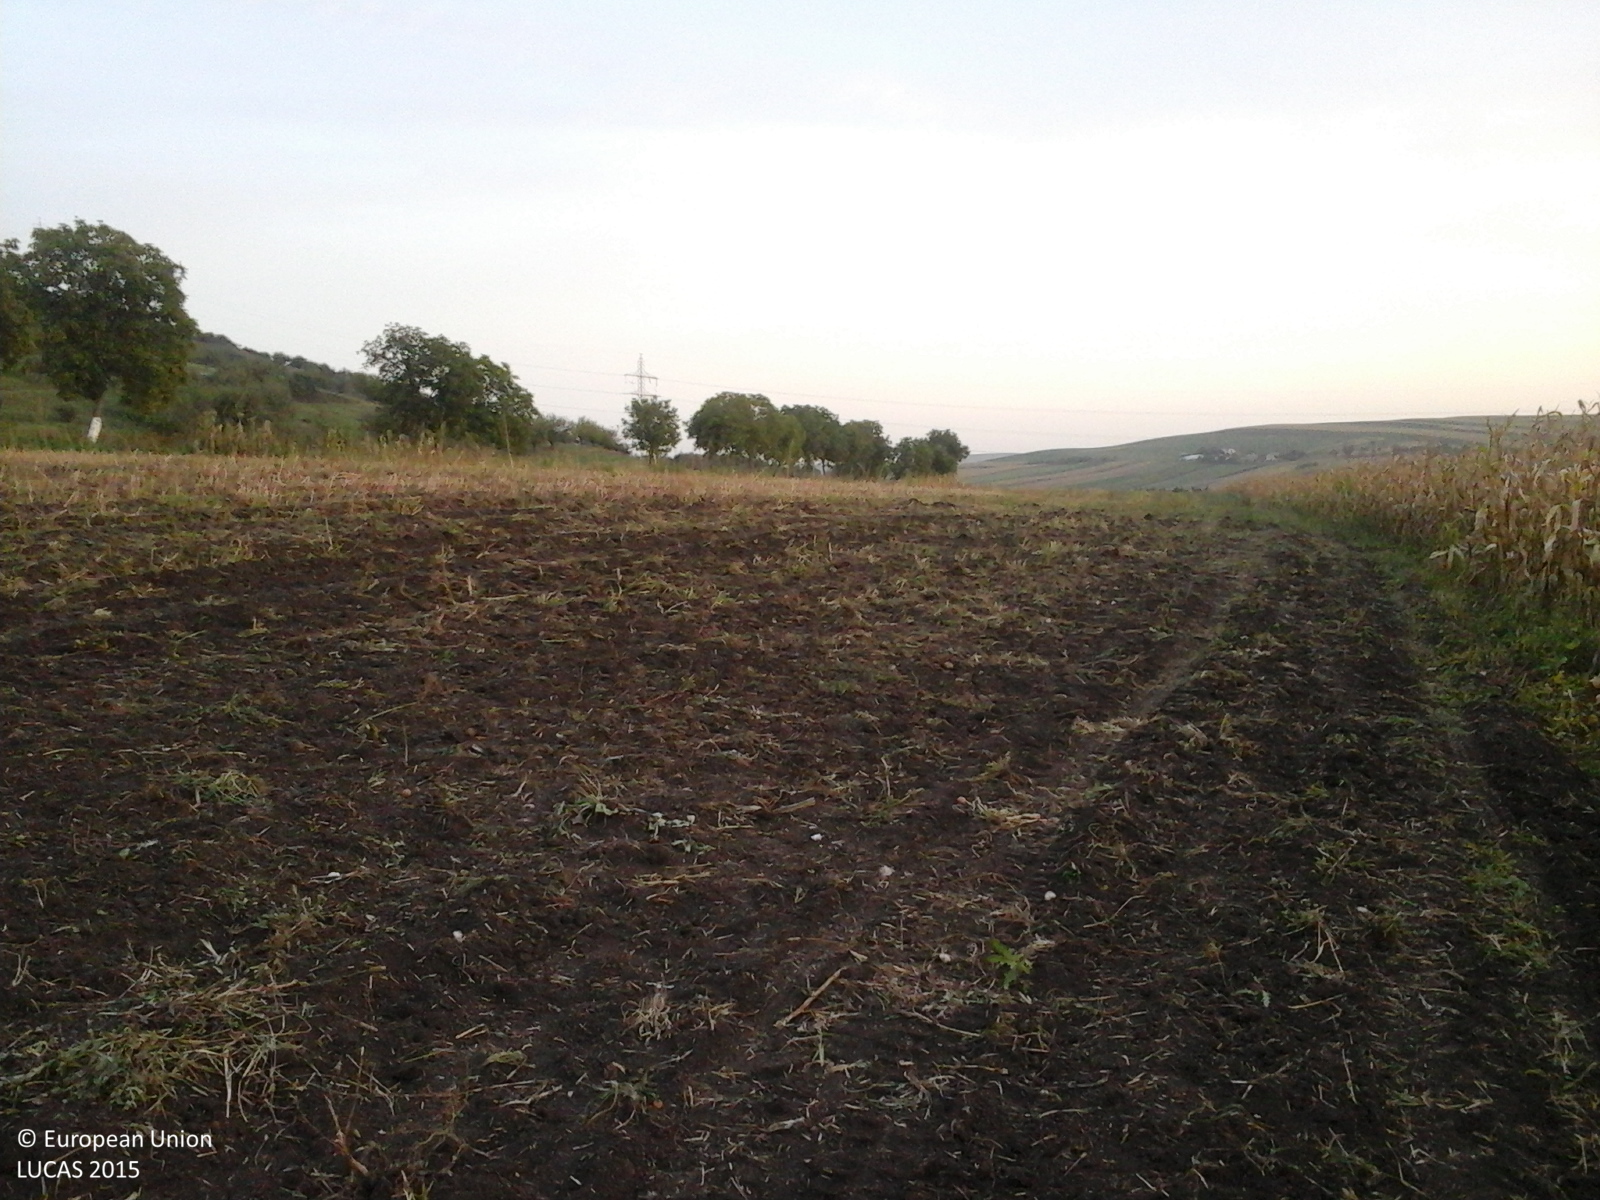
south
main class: Cropland
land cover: Potatoes
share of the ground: < 10 %
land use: Agriculture (excluding fallow land and kitchen gardens)
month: September
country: RO
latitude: 46.5758
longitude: 24.0000
